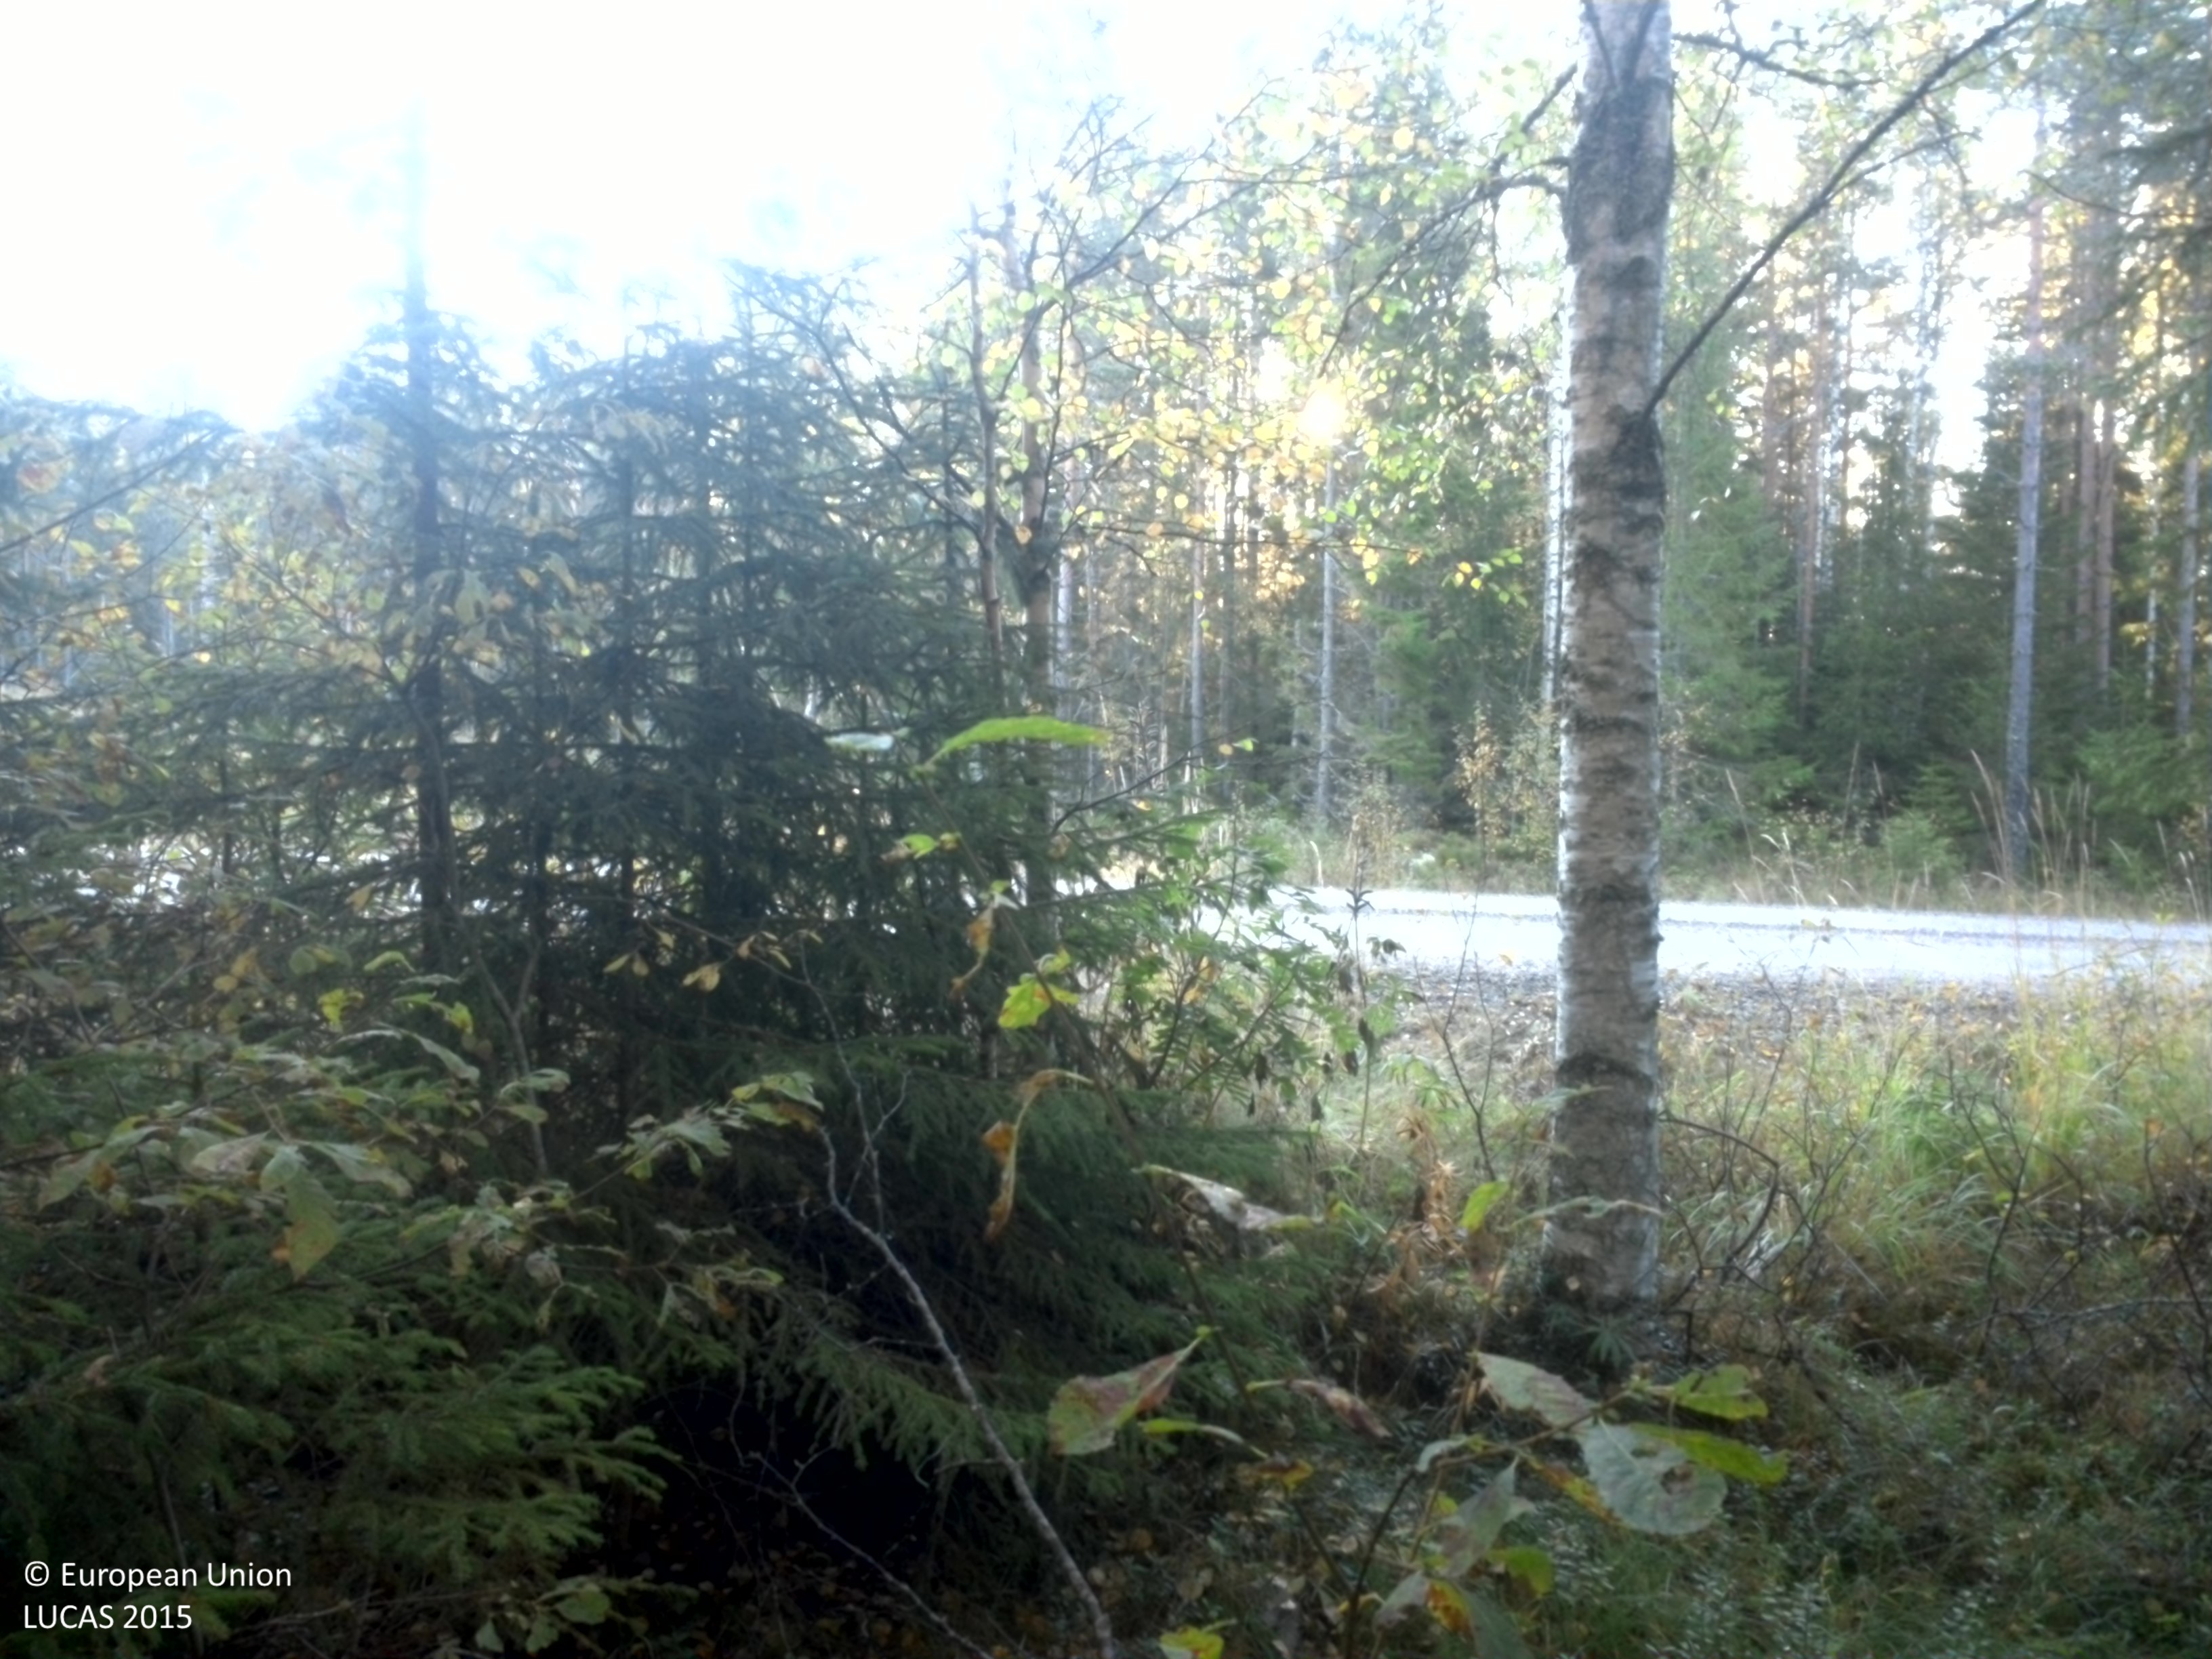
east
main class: Woodland
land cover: Pine dominated mixed woodland
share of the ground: > 75 %
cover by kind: coniferous forest trees 50 %, broadleaved forest trees 25 %, shrubs 10 %, lichens and mosses 10 %, herbaceous plants 5 %
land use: Forestry
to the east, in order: Pine dominated mixed woodland; Ditches and canals; Grass margins; Paved roads, cycling and walking lanes; Grass margins; Ditches and canals; Shrubland with sparse tree cover; Spruce dominated mixed woodland; Pine dominated mixed woodland; Tracks
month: September
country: SE
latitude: 59.9007
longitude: 15.2991
